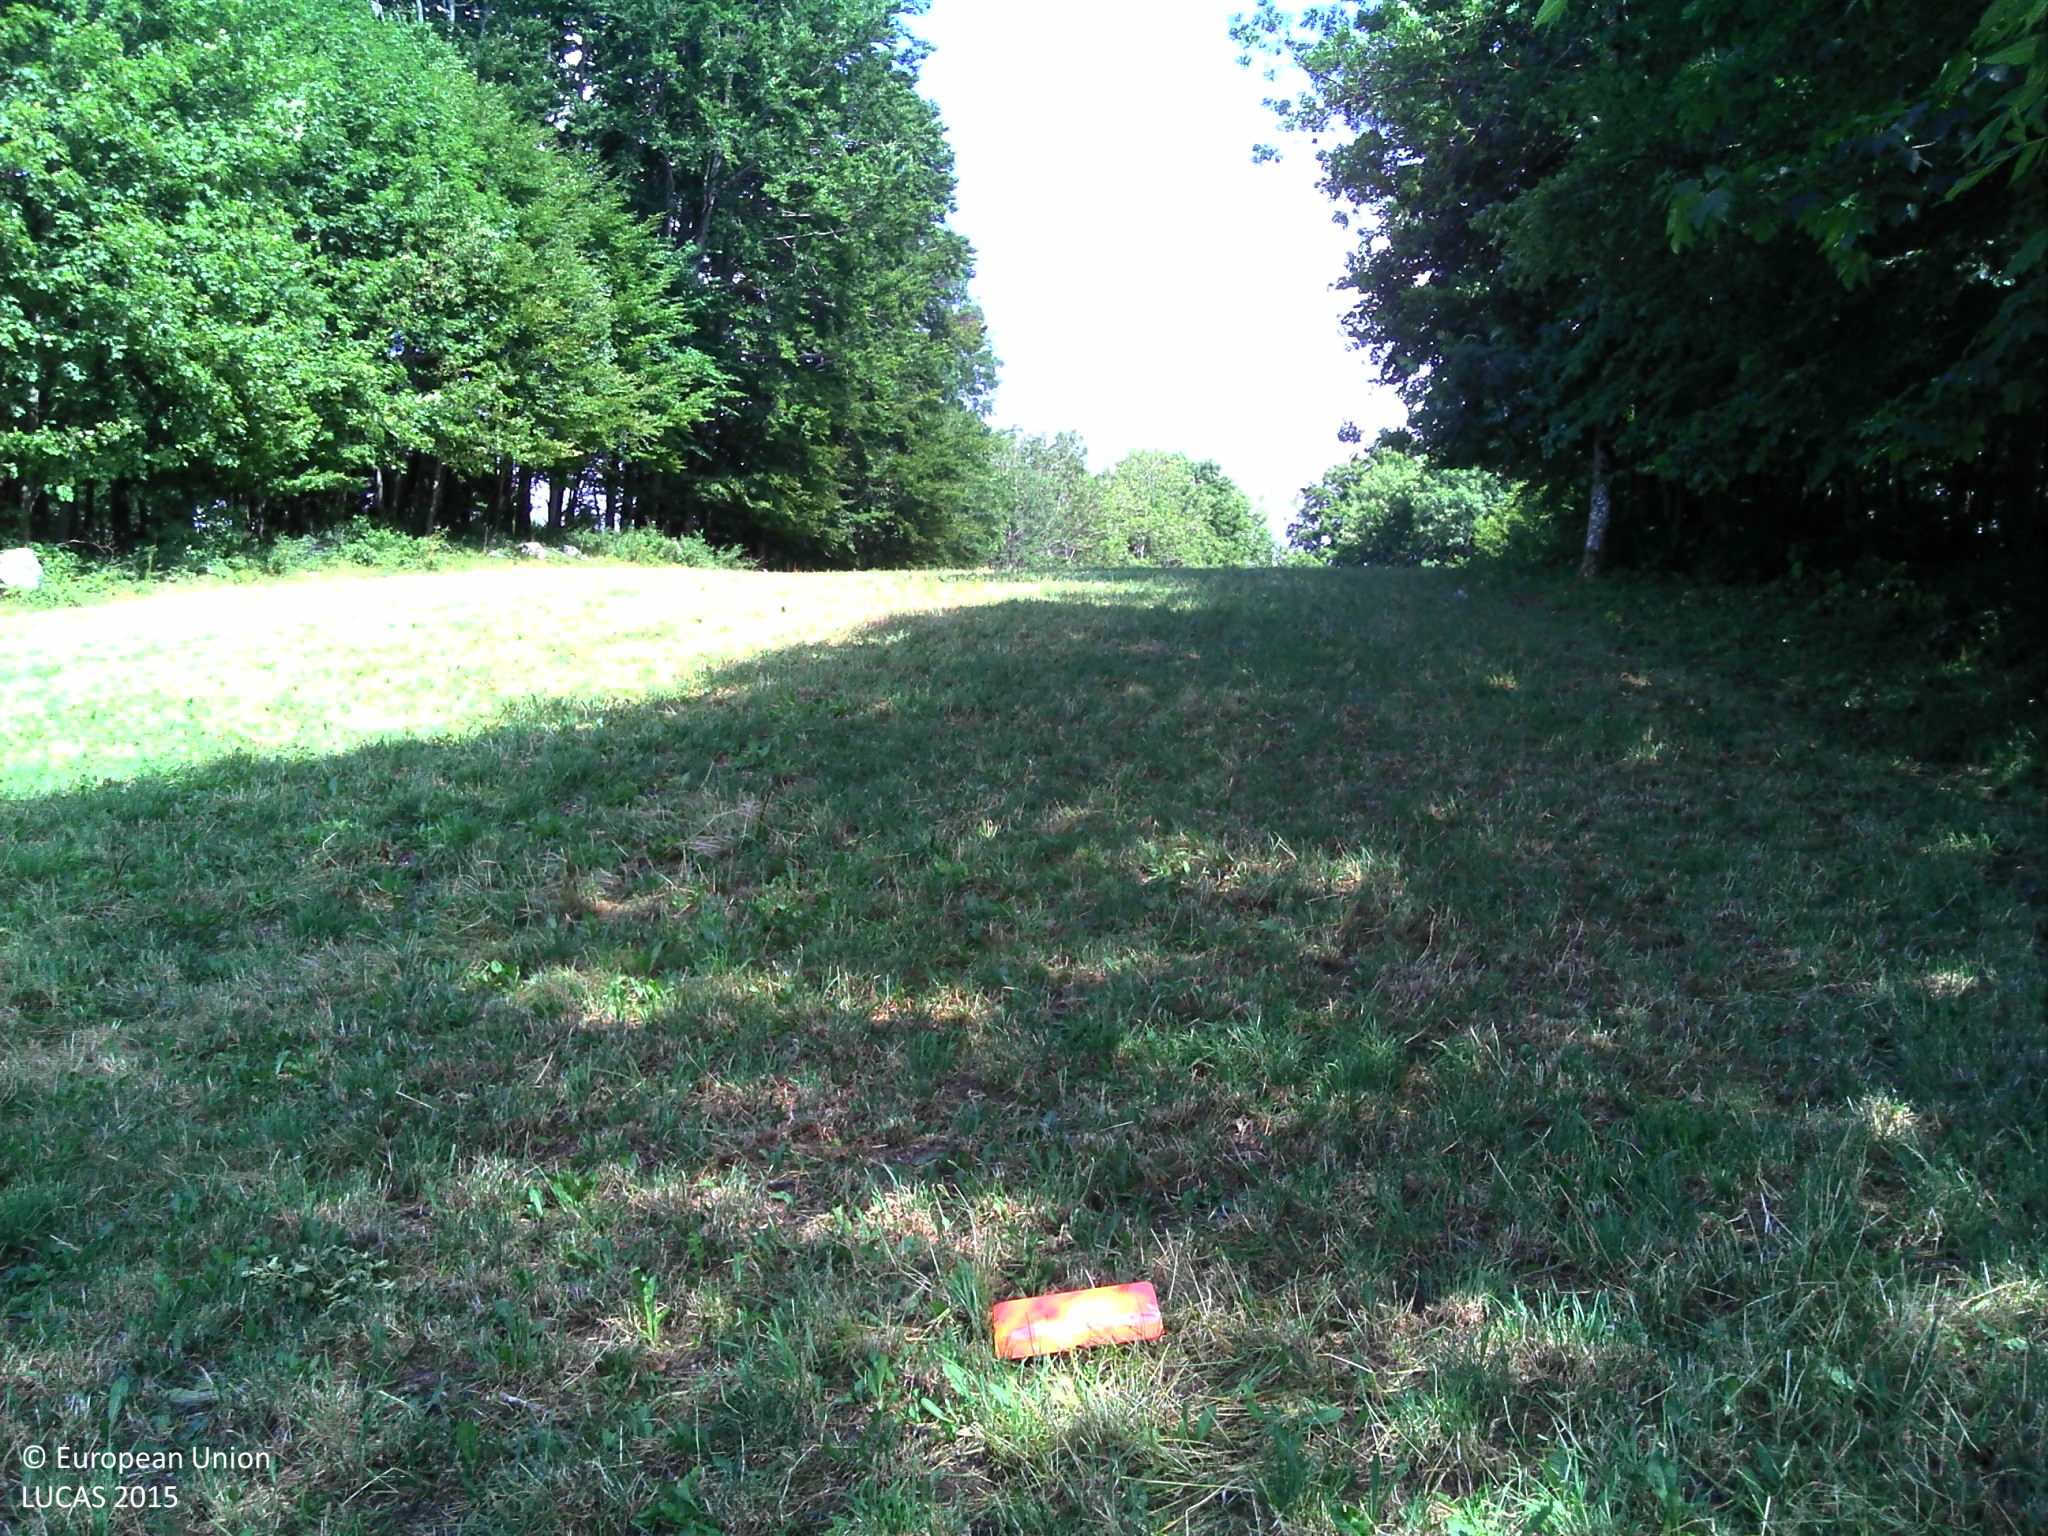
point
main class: Grassland
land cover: Grassland without tree/shrub cover
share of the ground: > 75 %
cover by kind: herbaceous plants 100 %
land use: Agriculture (excluding fallow land and kitchen gardens)
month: July
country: FR
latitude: 46.7655
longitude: 6.0612
